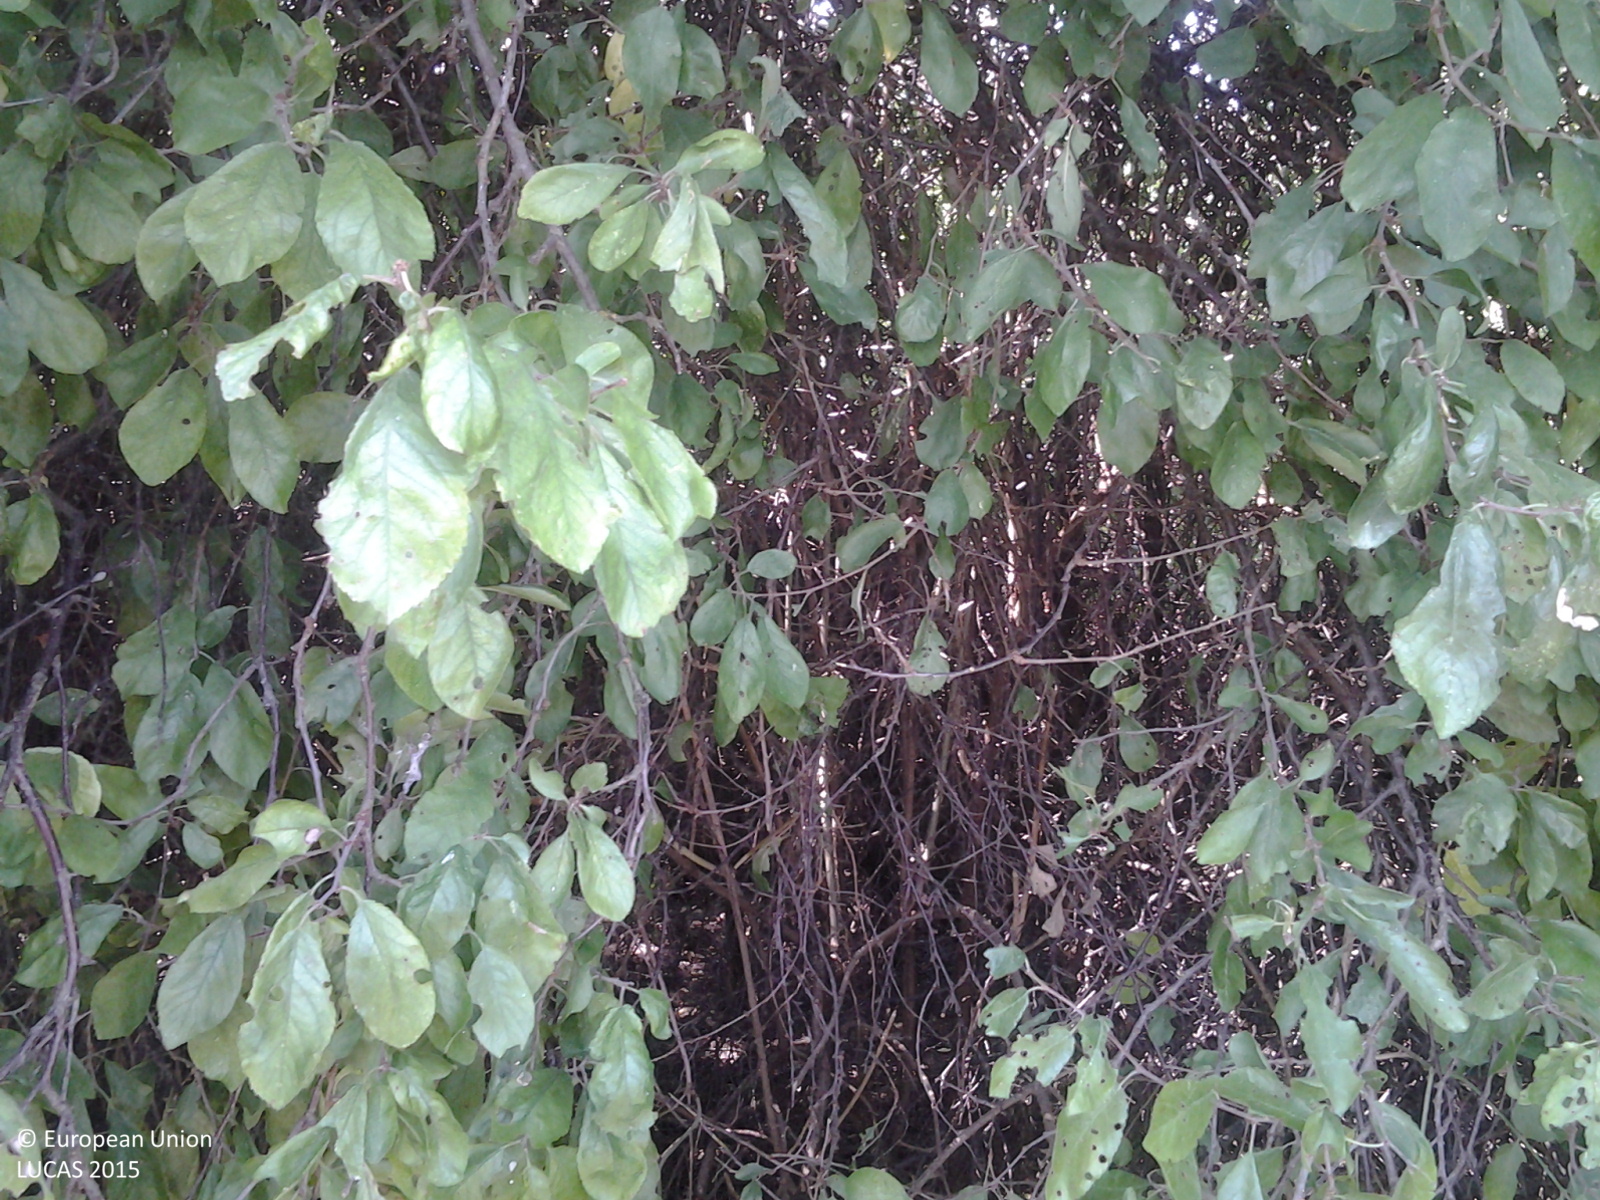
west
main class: Shrubland
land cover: Shrubland without tree cover
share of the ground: > 75 %
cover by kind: shrubs 90 %, herbaceous plants 10 %
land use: Abandoned areas
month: August
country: HU
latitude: 46.5568
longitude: 16.9814
